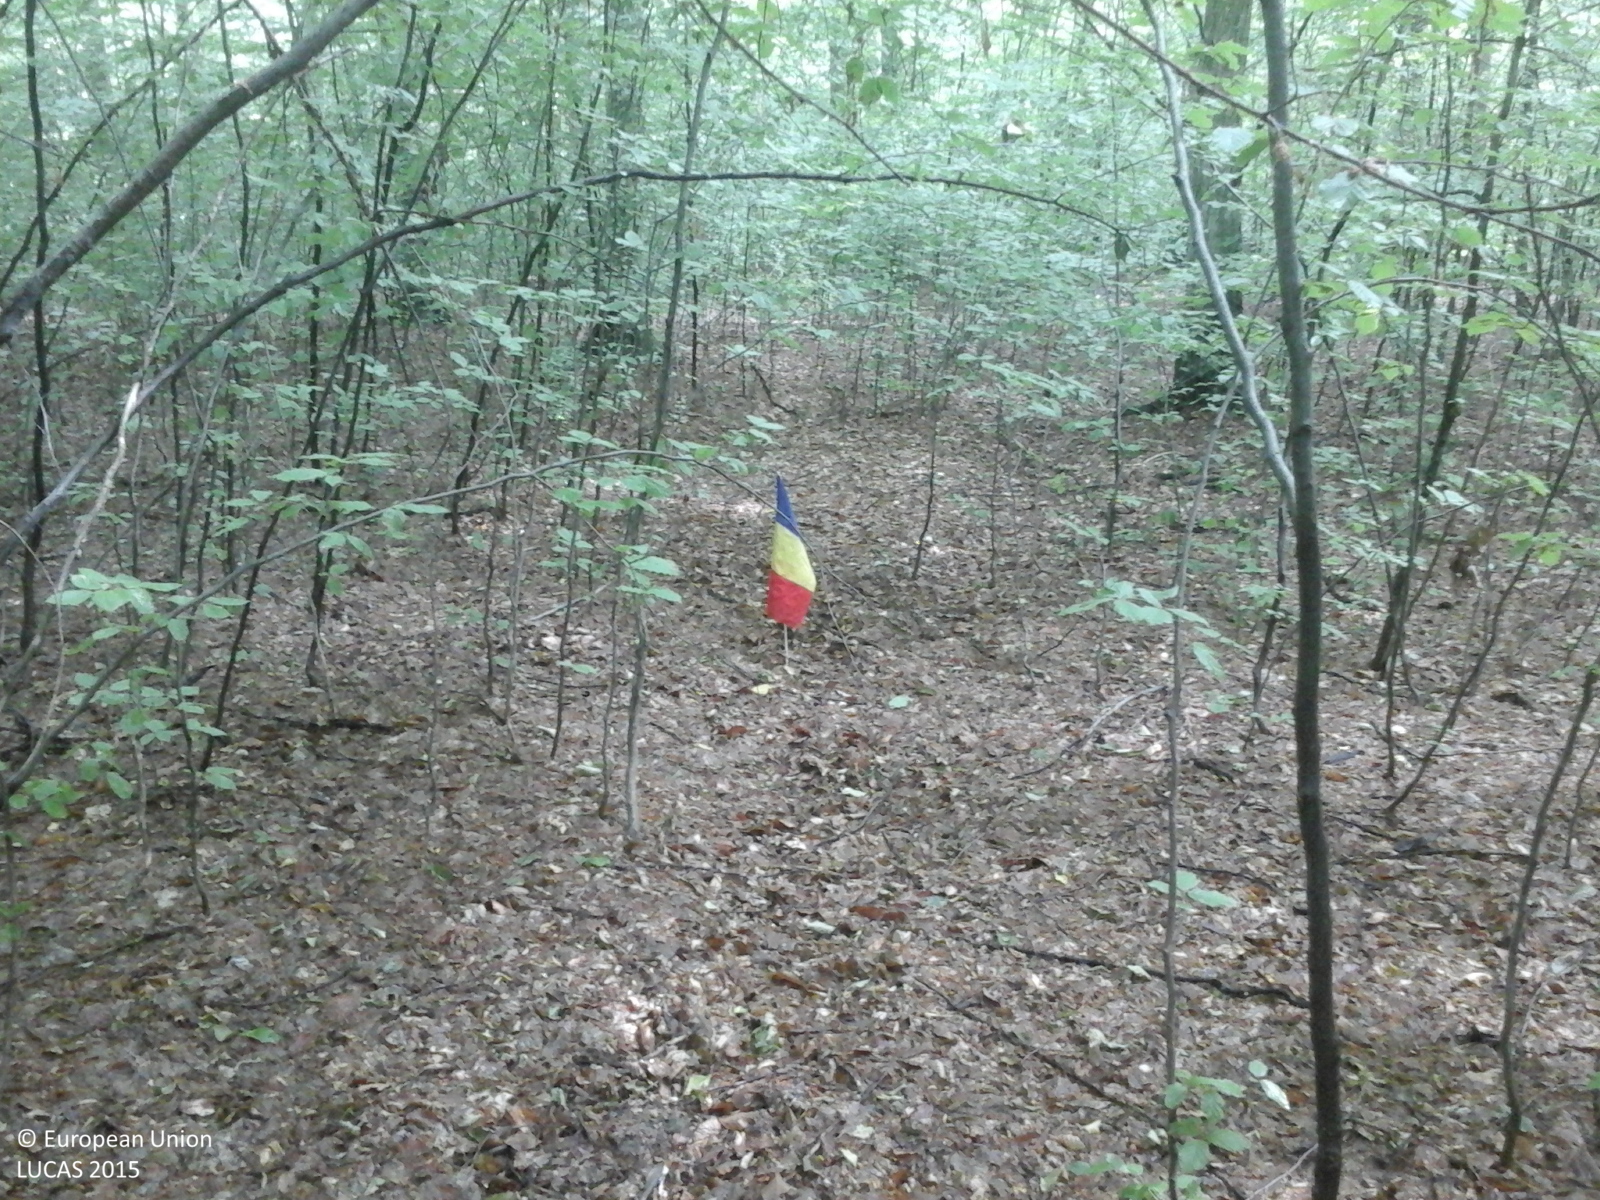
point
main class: Woodland
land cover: Broadleaved woodland
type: beech forest
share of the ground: 50 - 75 %
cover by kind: broadleaved forest trees 90 %, shrubs 10 %
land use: Forestry
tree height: > 5 m
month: June
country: RO
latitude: 47.2706
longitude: 26.3275
